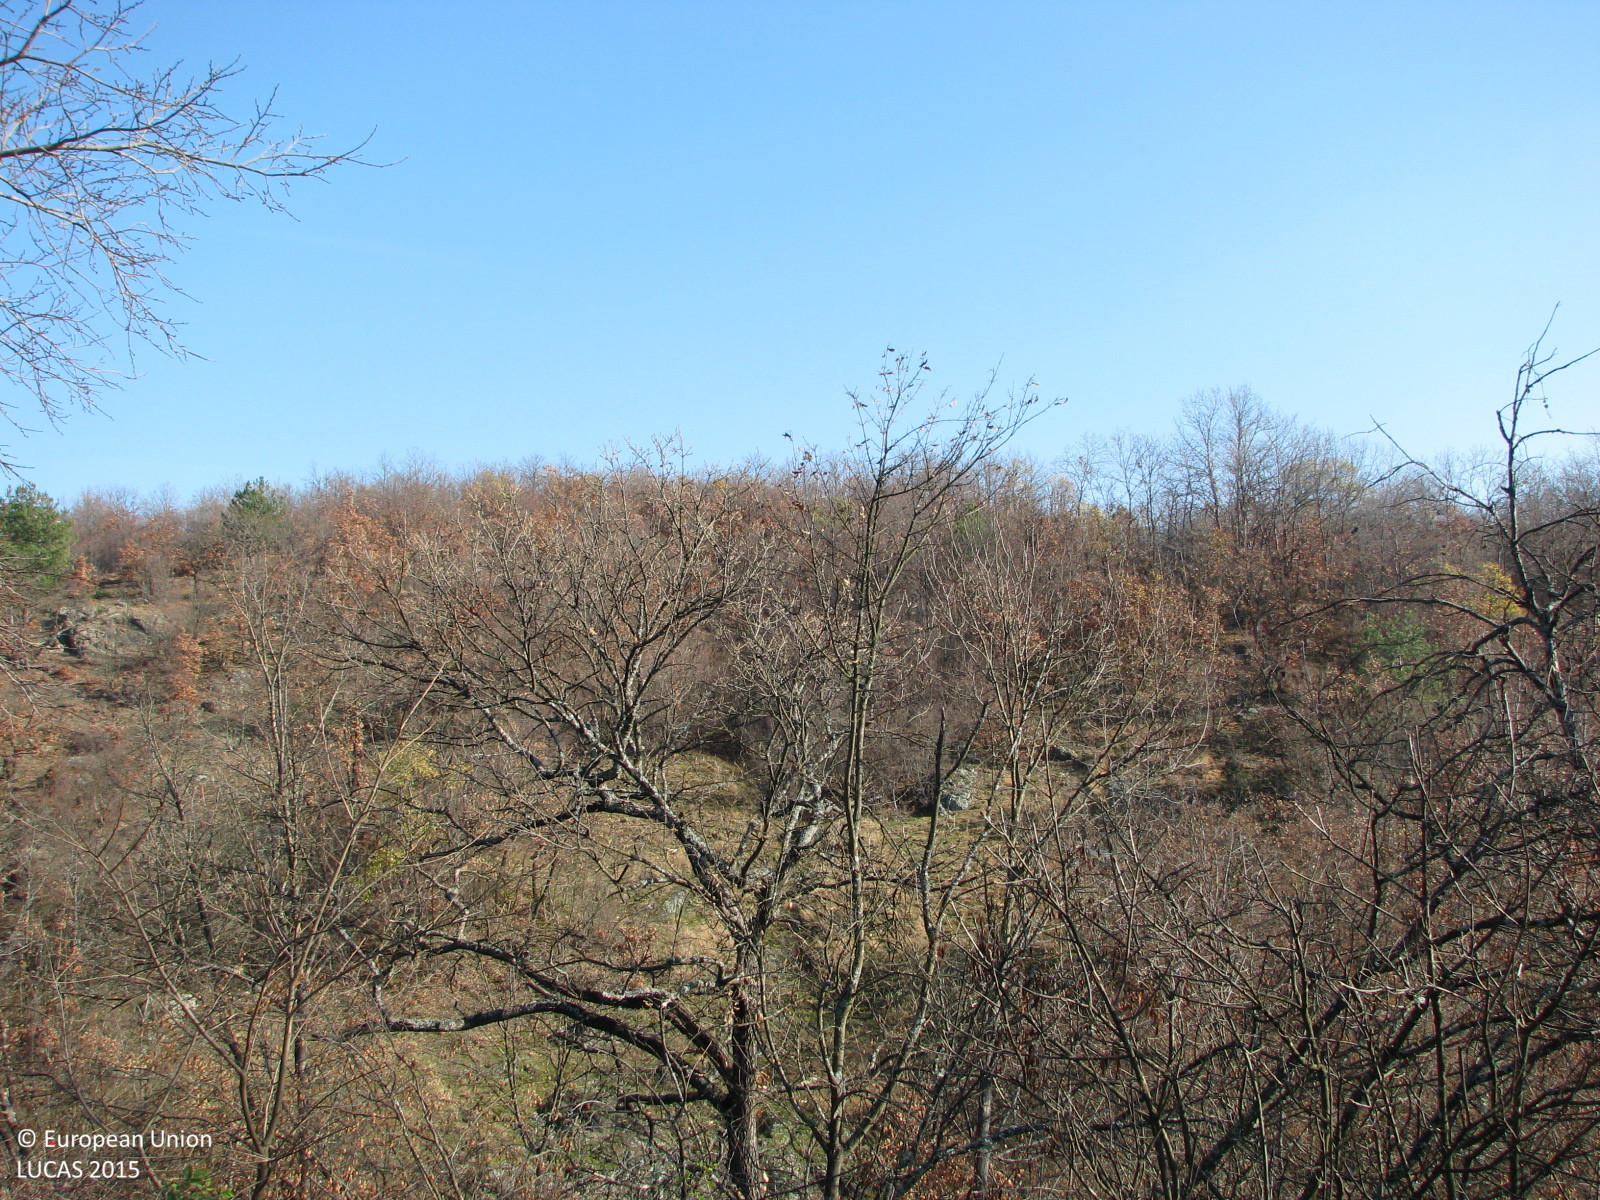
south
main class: Grassland
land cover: Grassland with sparse tree/shrub cover
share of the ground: > 75 %
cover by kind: herbaceous plants 85 %, shrubs 10 %, broadleaved forest trees 5 %
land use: Agriculture (excluding fallow land and kitchen gardens)
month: December
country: BG
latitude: 42.4661
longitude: 24.2392
